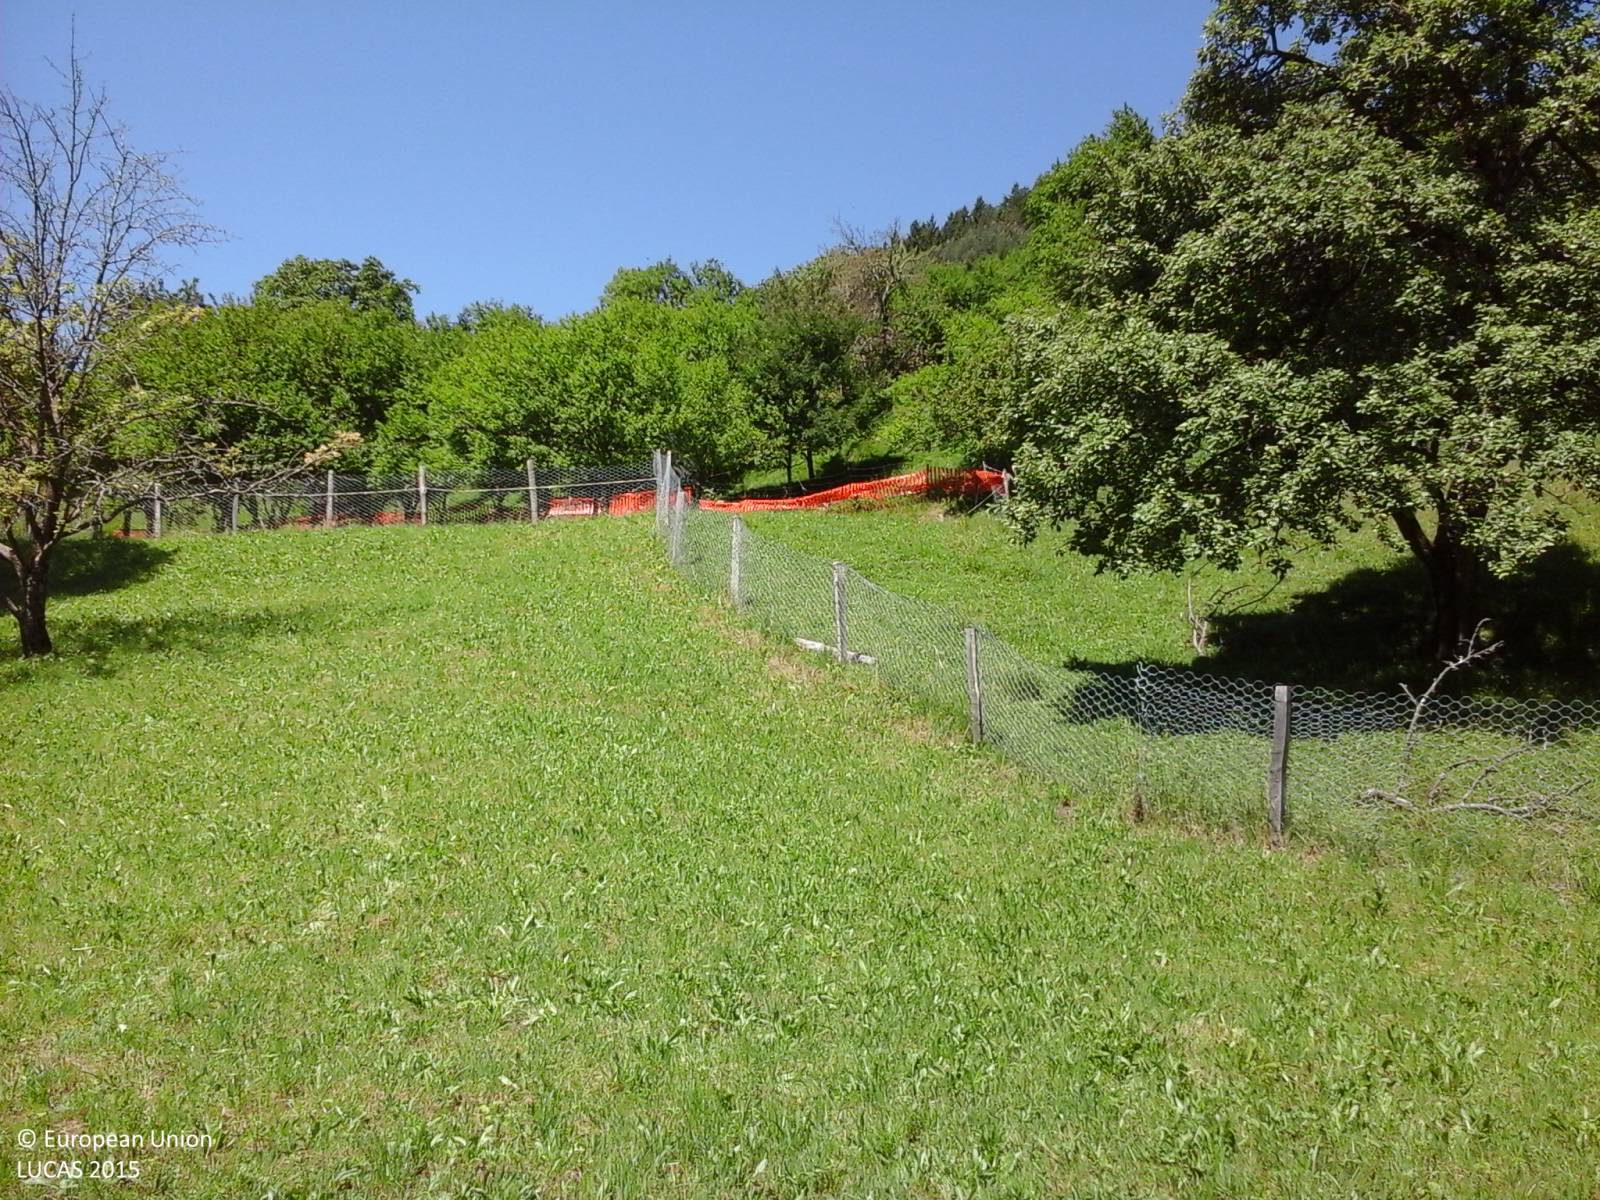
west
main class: Grassland
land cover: Grassland without tree/shrub cover
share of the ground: > 75 %
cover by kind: herbaceous plants 100 %
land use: Agriculture (excluding fallow land and kitchen gardens)
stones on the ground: < 10 %
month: June
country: IT
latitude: 46.4870
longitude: 13.0845
